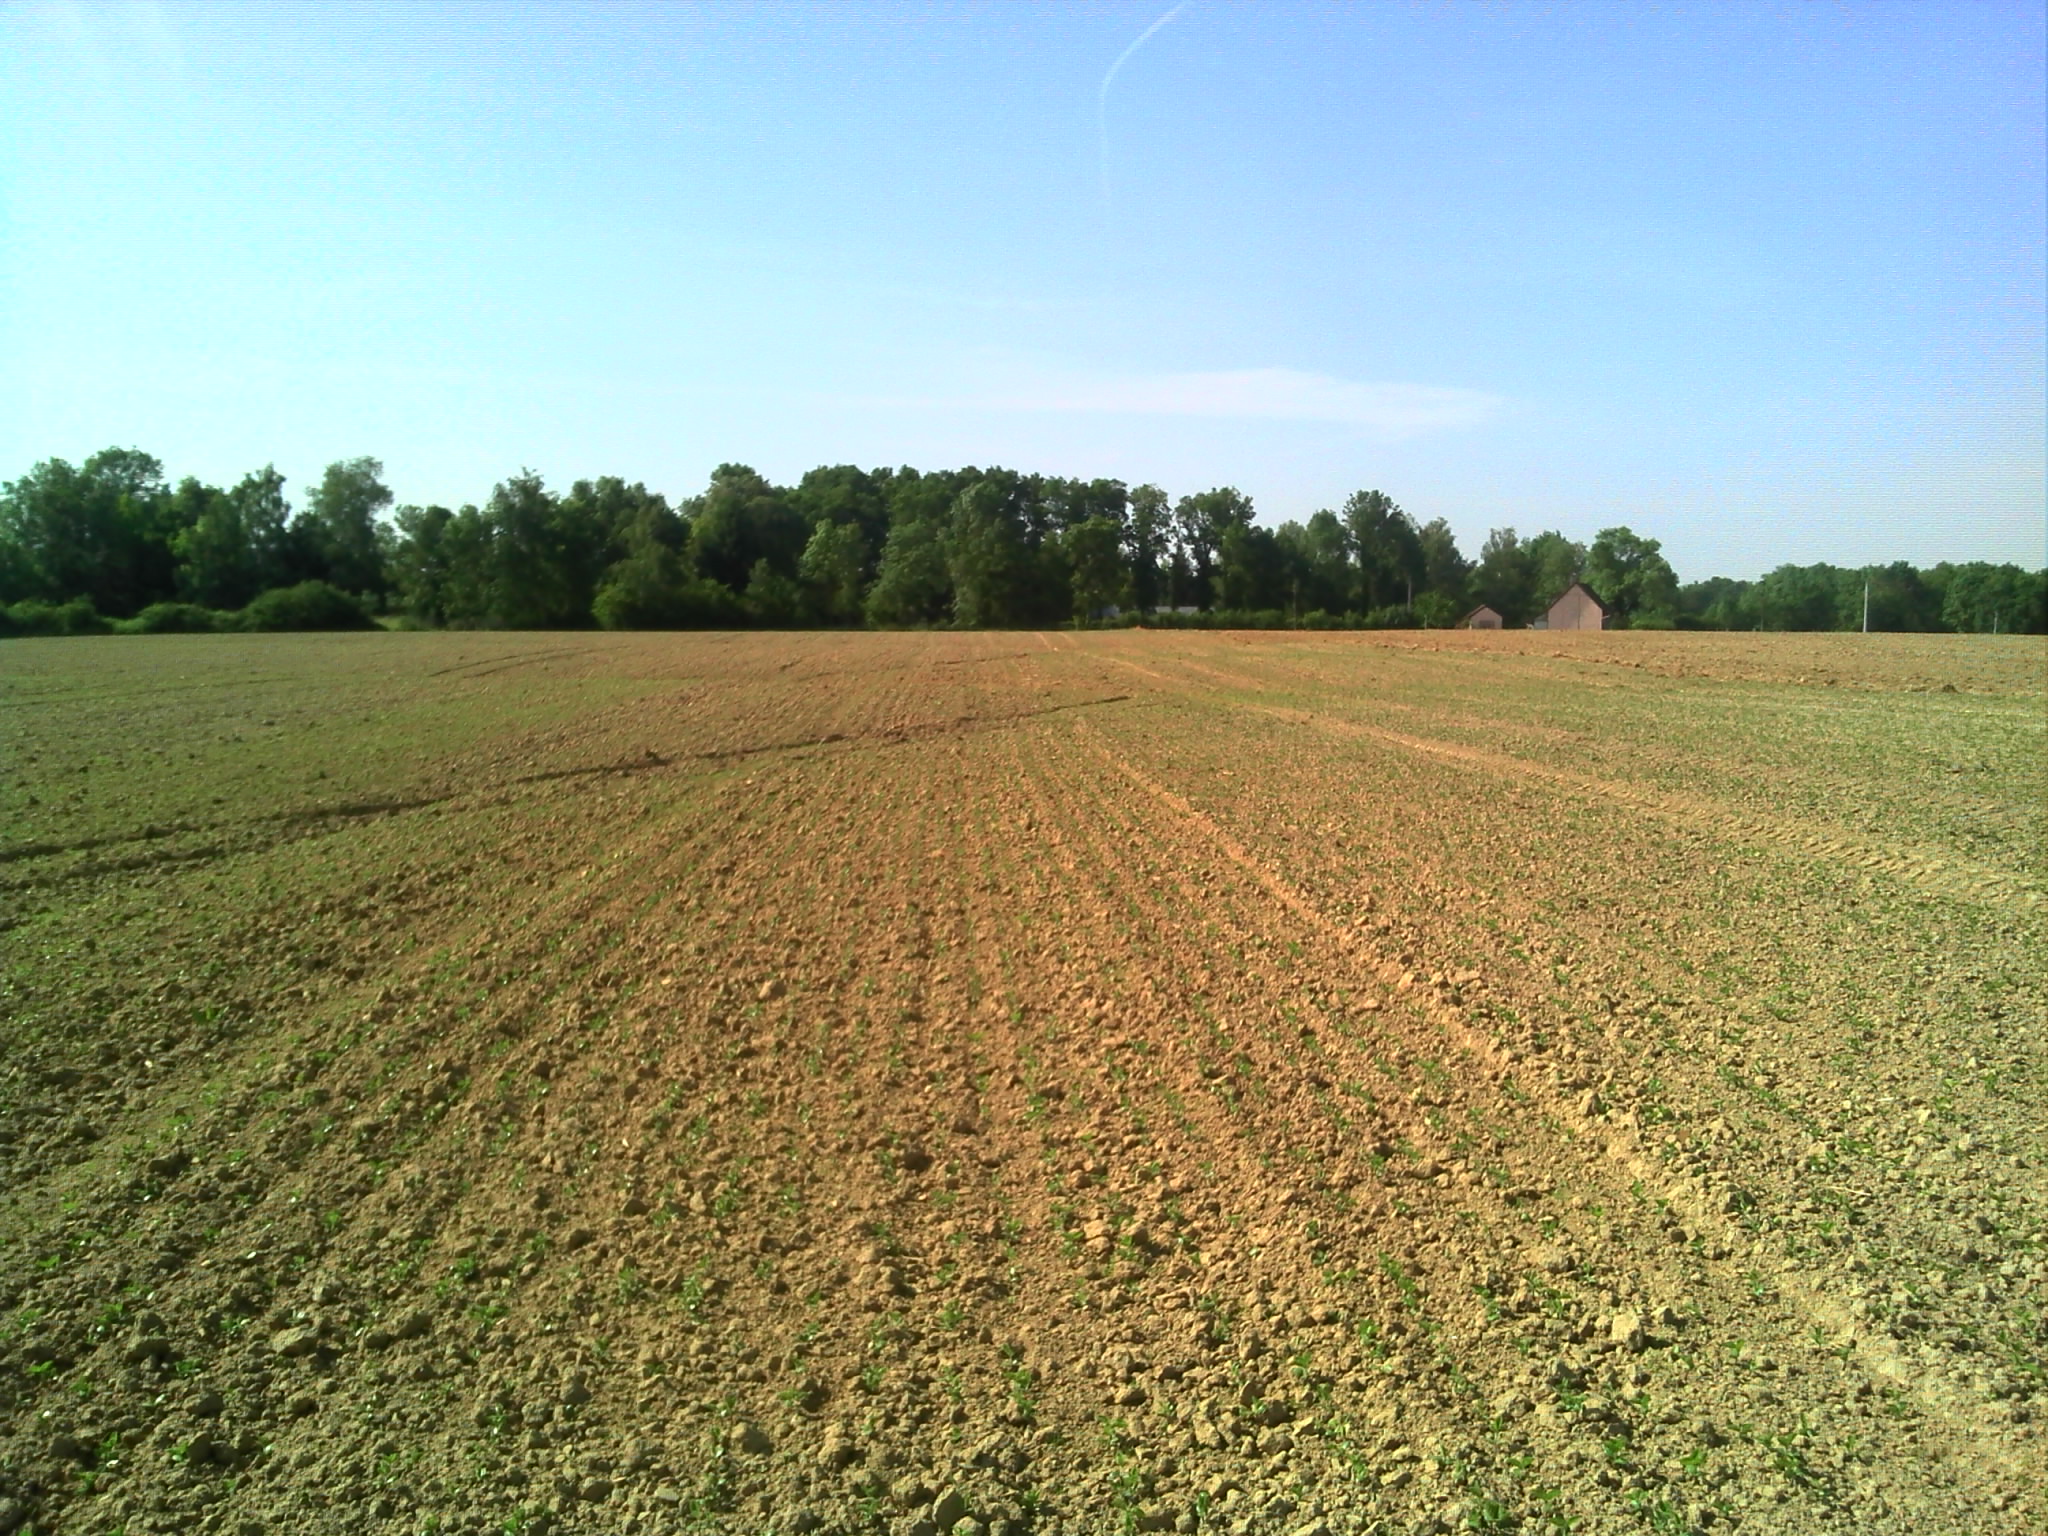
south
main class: Cropland
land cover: Soya
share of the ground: < 10 %
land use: Agriculture (excluding fallow land and kitchen gardens)
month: May
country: FR
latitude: 46.5606
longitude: 5.0320
